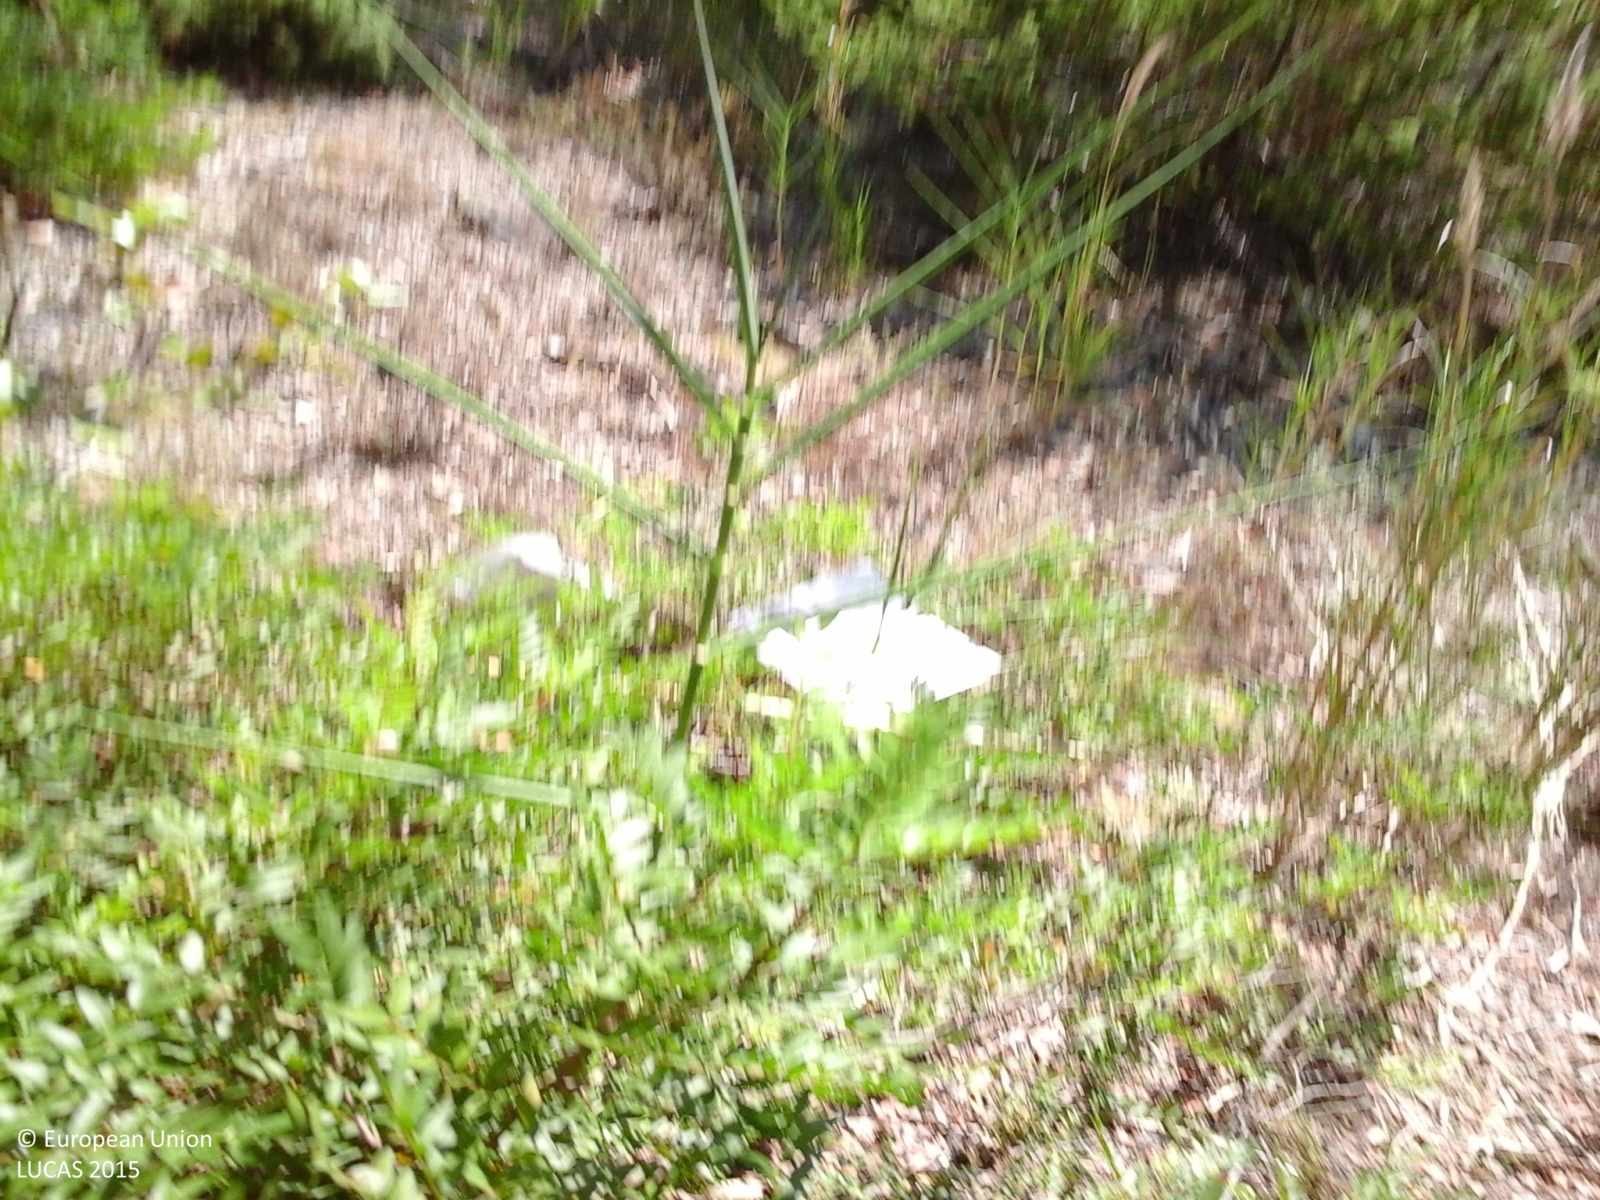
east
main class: Shrubland
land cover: Shrubland with sparse tree cover
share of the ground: > 75 %
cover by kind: shrubs 85 %, herbaceous plants 10 %, broadleaved forest trees 5 %
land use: Semi-natural and natural areas not in use
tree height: < 5 m
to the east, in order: Shrubland with sparse tree cover; Grassland without tree/shrub cover; Broadleaved woodland
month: July
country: IT
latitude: 42.9672
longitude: 11.5522
